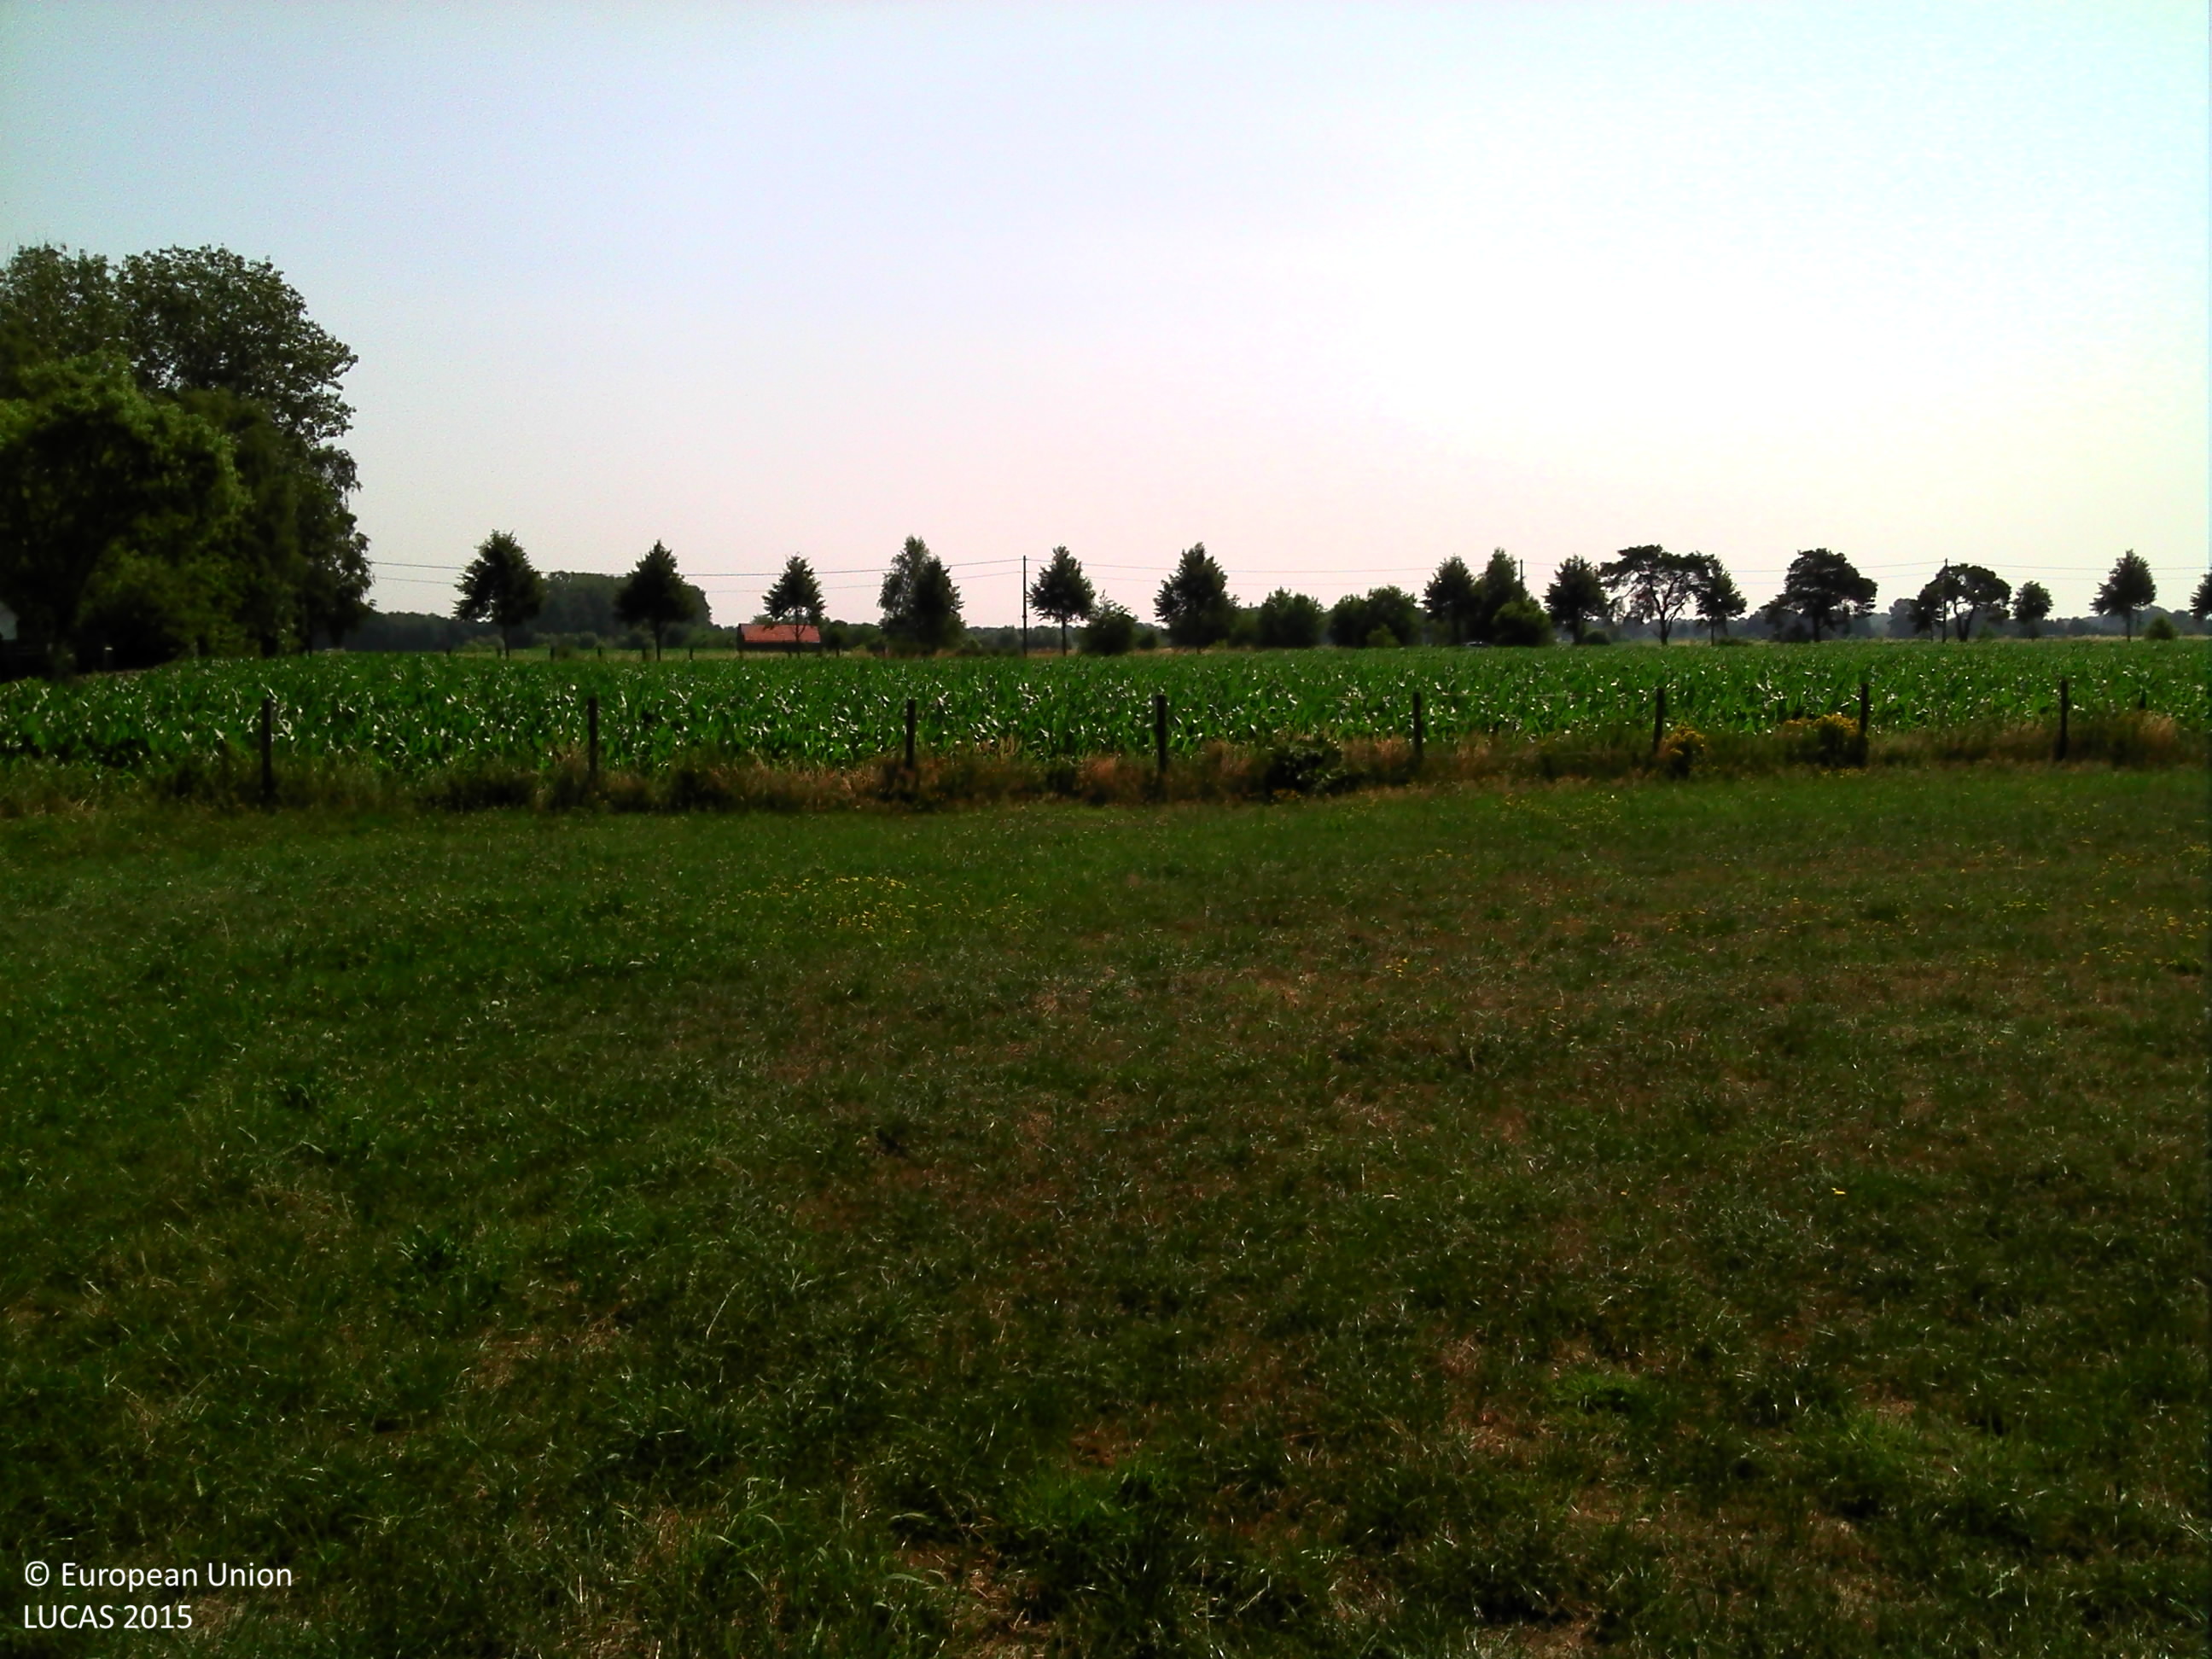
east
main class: Grassland
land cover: Grassland without tree/shrub cover
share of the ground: > 75 %
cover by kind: herbaceous plants 100 %
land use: Agriculture (excluding fallow land and kitchen gardens)
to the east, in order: Grassland without tree/shrub cover; Fences; Grass margins; Maize; Grass margins; Electric lines; Ditches and canals; Grass margins; Paved roads, cycling and walking lanes; Grass margins; Lines of trees; Grass margins; Fences; Maize
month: July
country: BE
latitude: 51.0849
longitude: 5.4727
